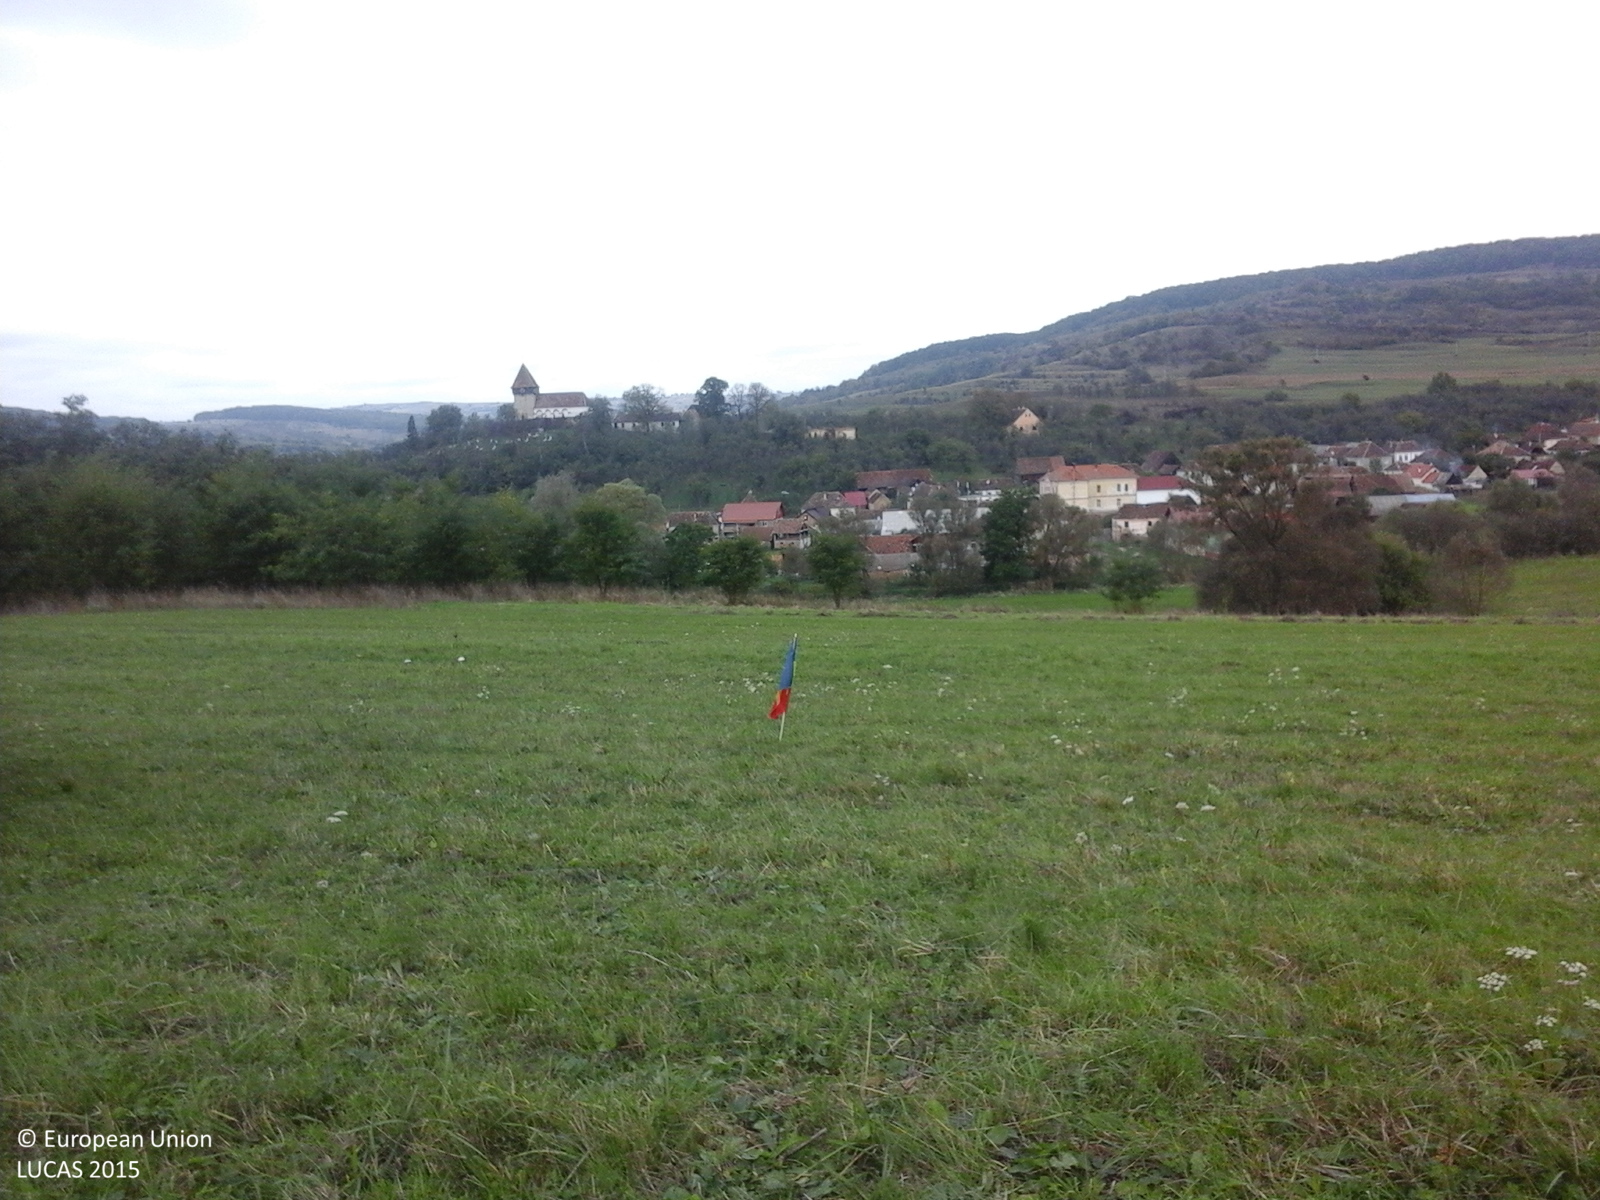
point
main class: Grassland
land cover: Grassland without tree/shrub cover
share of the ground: > 75 %
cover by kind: herbaceous plants 100 %
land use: Agriculture (excluding fallow land and kitchen gardens)
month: October
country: RO
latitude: 45.9077
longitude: 24.8763
